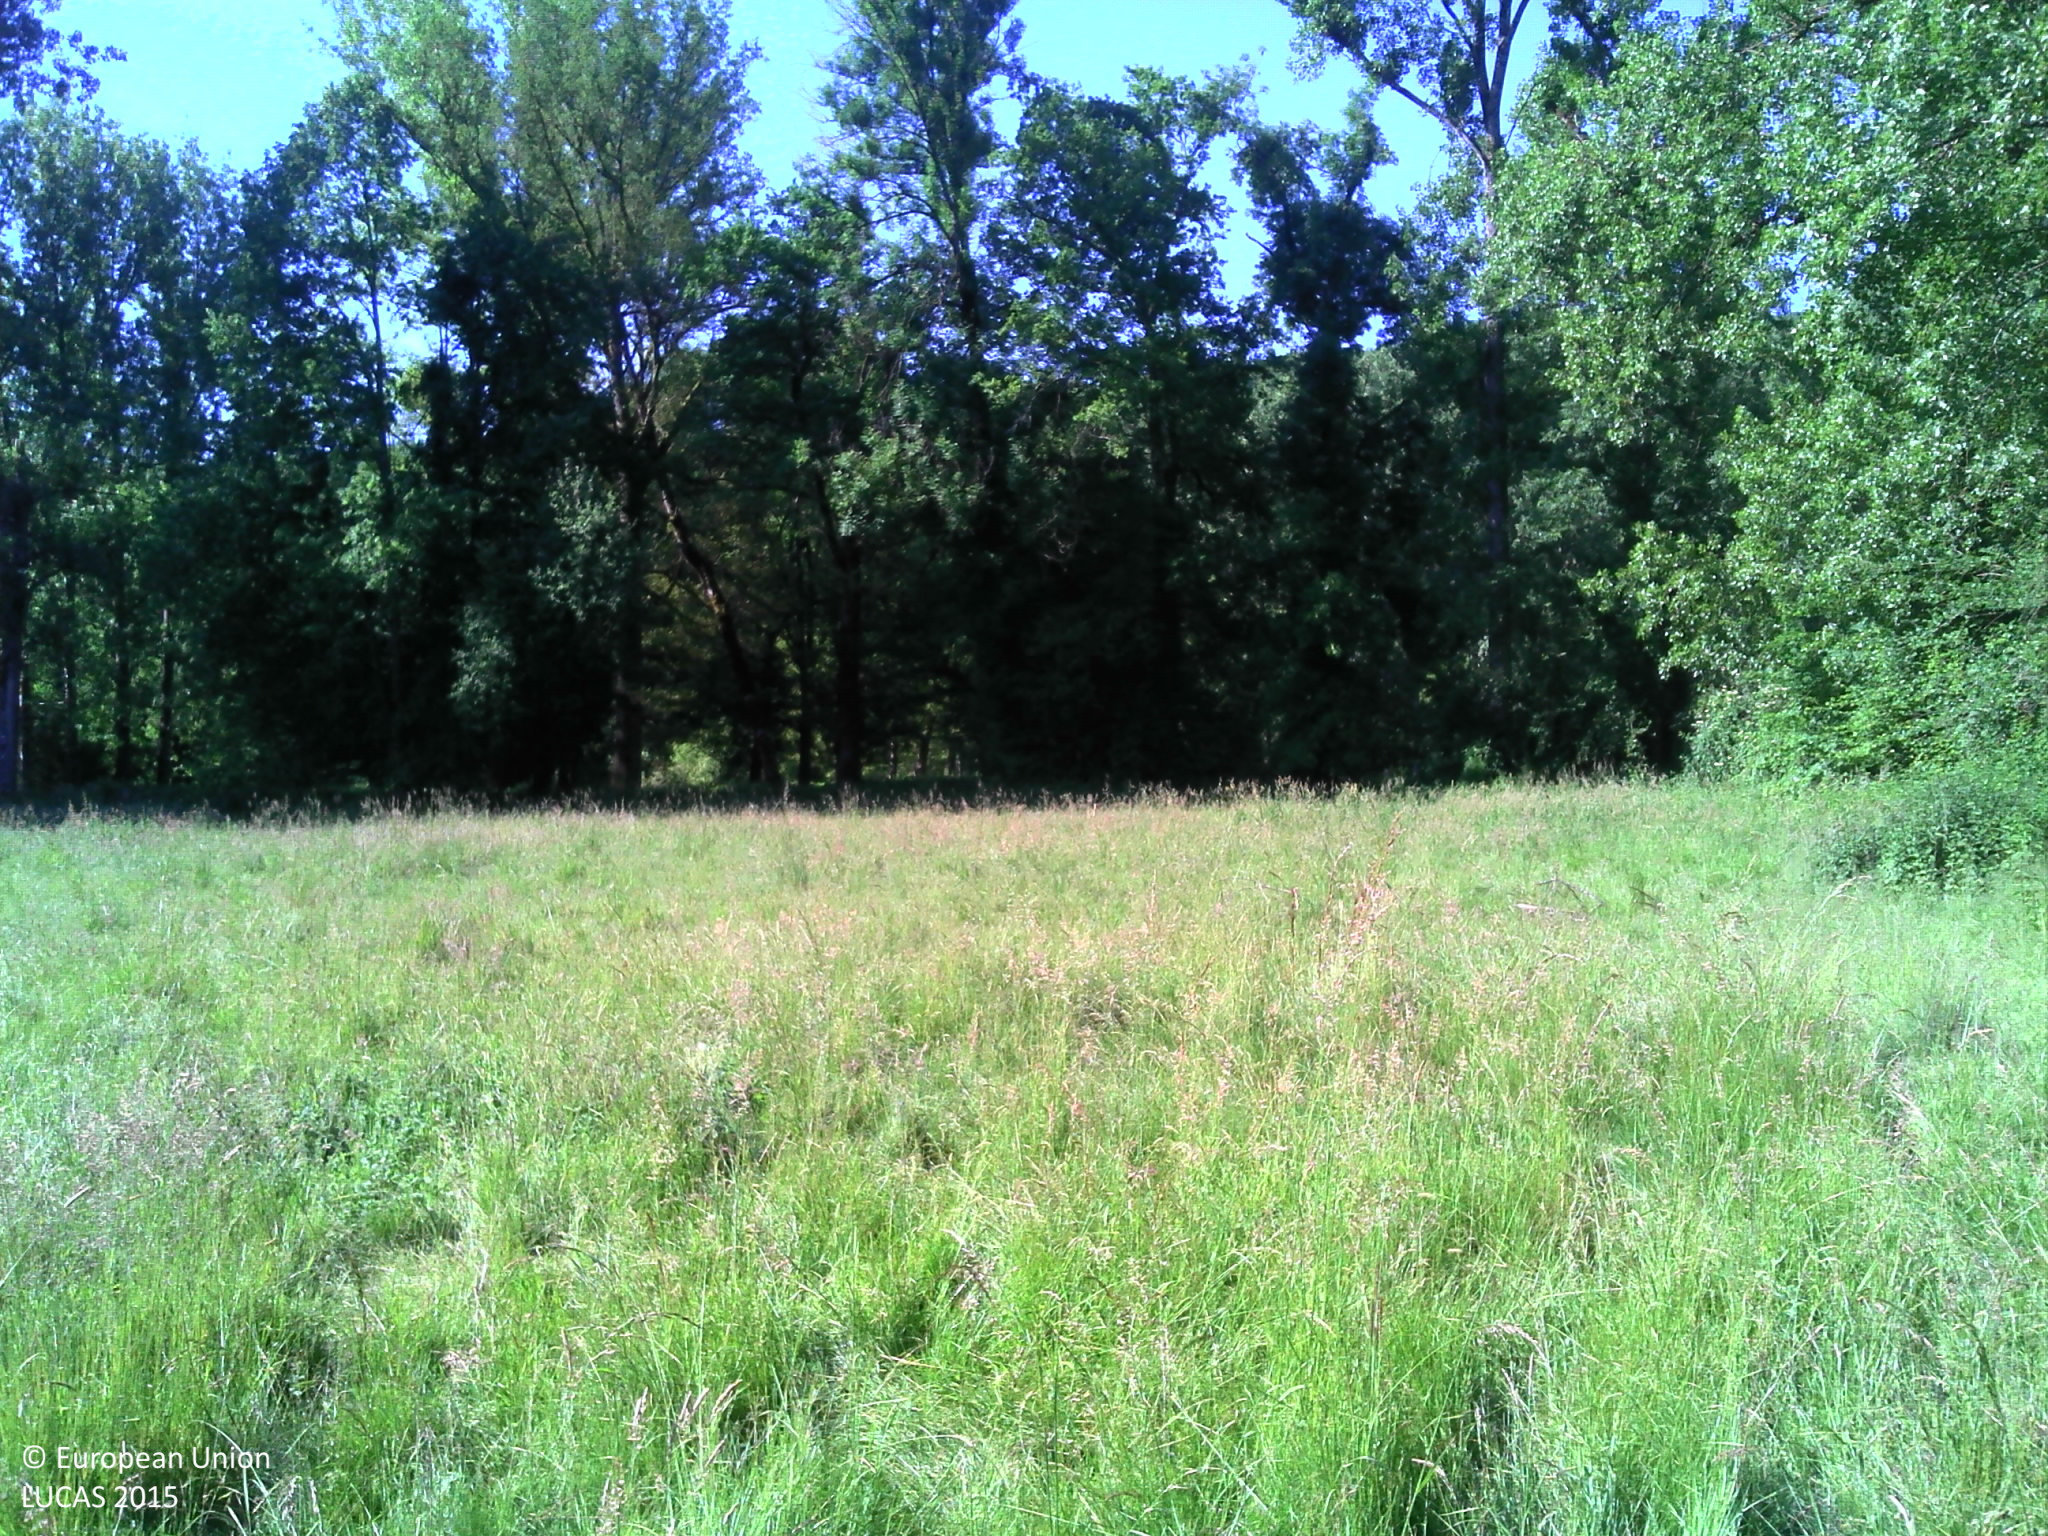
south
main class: Grassland
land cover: Grassland without tree/shrub cover
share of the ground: > 75 %
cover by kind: herbaceous plants 100 %
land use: Agriculture (excluding fallow land and kitchen gardens)
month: May
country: FR
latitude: 44.5971
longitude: 1.9245
